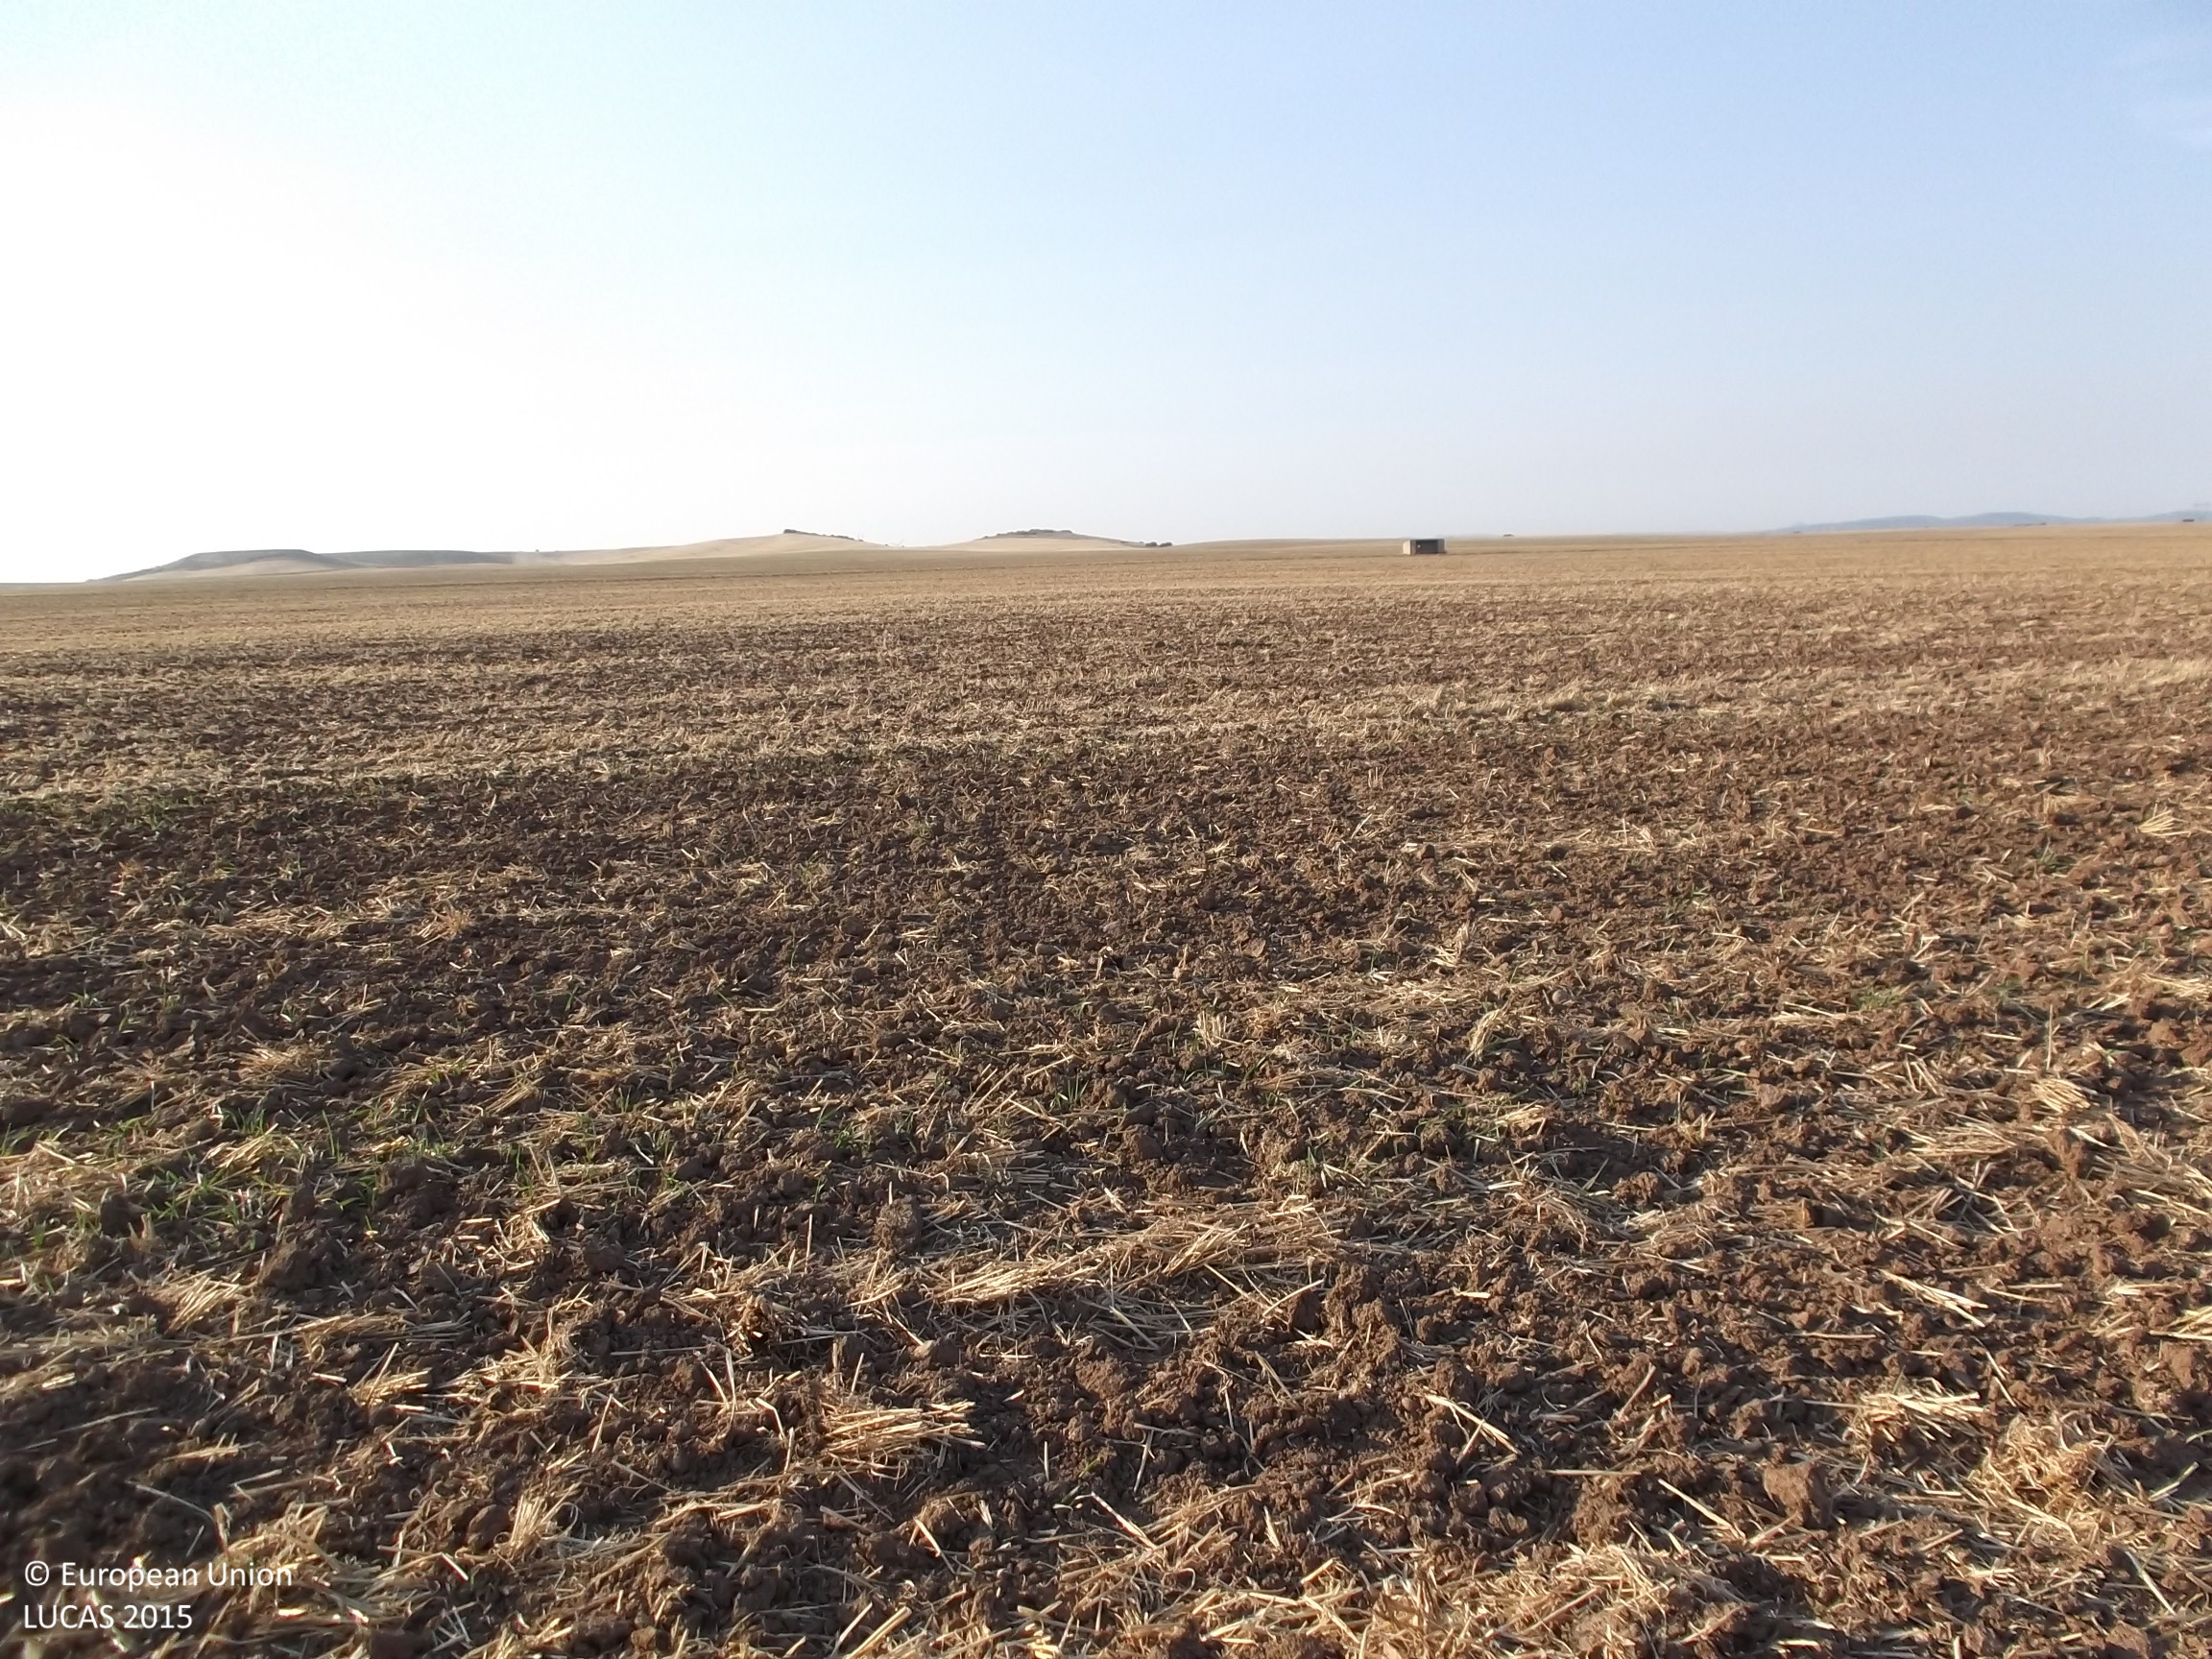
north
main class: Cropland
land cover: Barley
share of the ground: < 10 %
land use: Agriculture (excluding fallow land and kitchen gardens)
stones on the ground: < 10 %
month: July
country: ES
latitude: 42.3944
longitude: -1.6858
